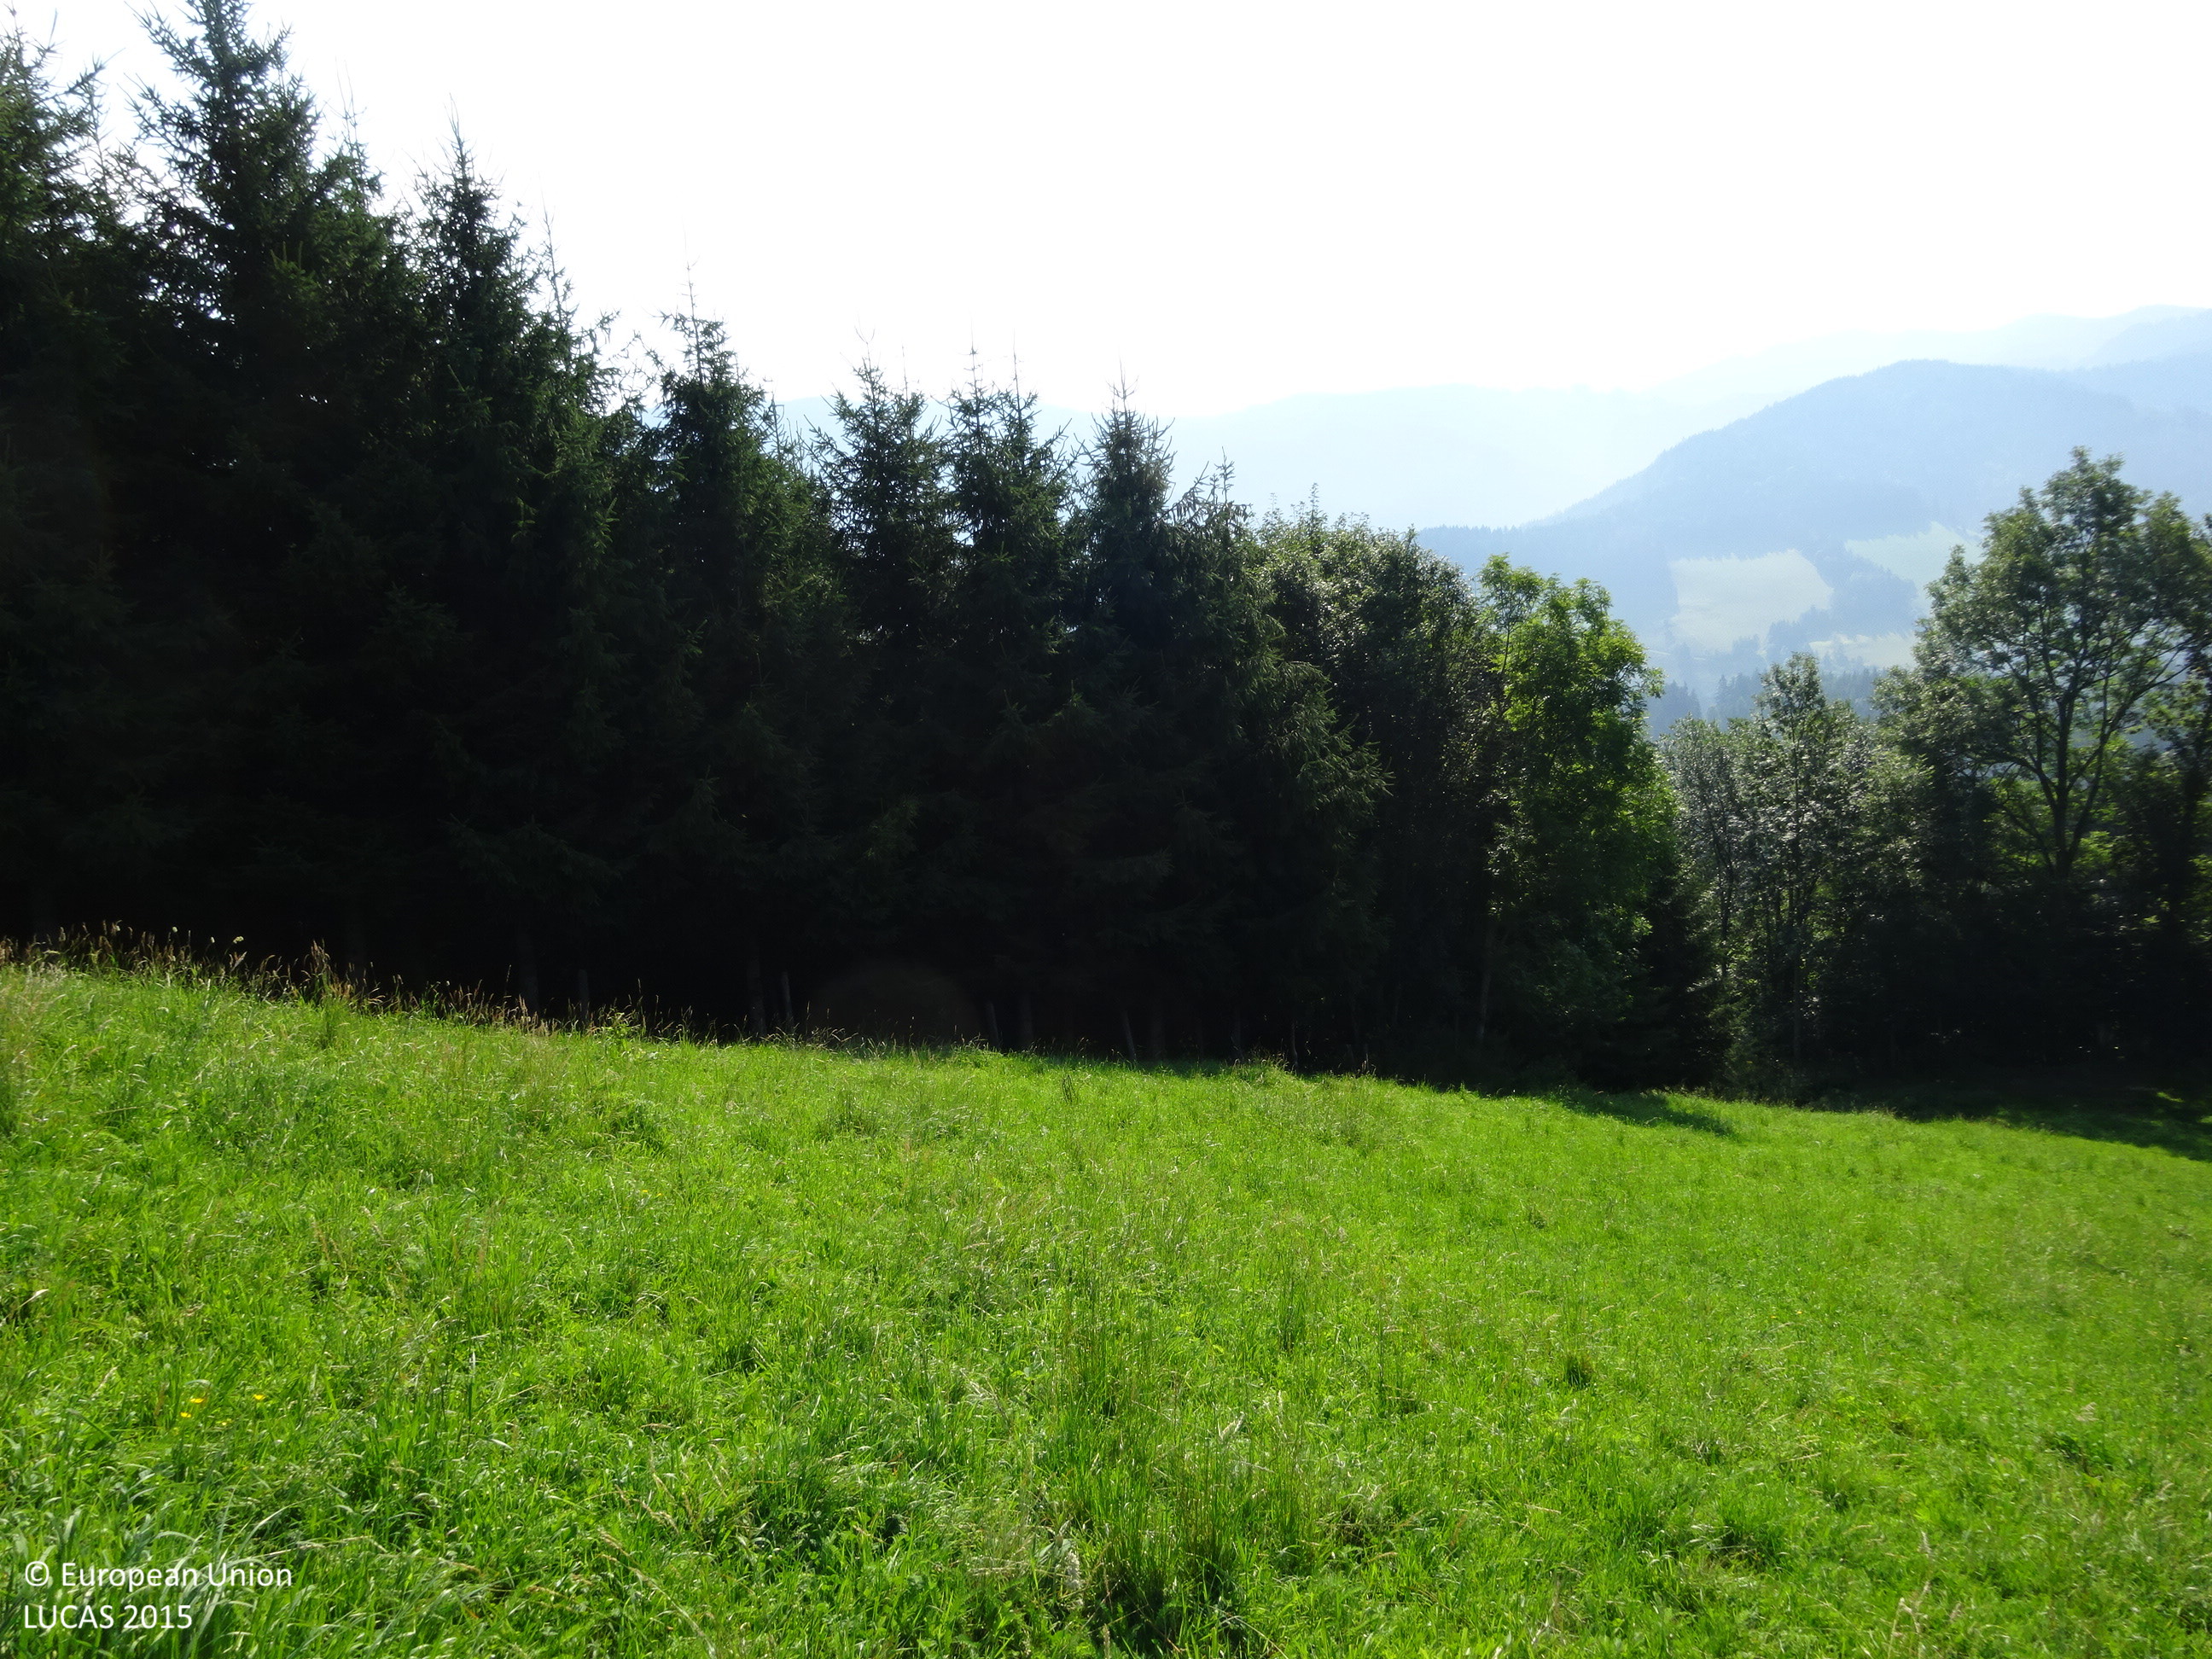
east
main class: Grassland
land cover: Grassland without tree/shrub cover
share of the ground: > 75 %
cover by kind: herbaceous plants 100 %
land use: Agriculture (excluding fallow land and kitchen gardens)
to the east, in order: Grassland without tree/shrub cover; Fences; Spruce dominated coniferous woodland; Tracks; Spruce dominated mixed woodland; Spruce dominated coniferous woodland; Shrubland with sparse tree cover; Spruce dominated mixed woodland; Spruce dominated coniferous woodland
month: August
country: AT
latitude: 47.4367
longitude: 15.5034
